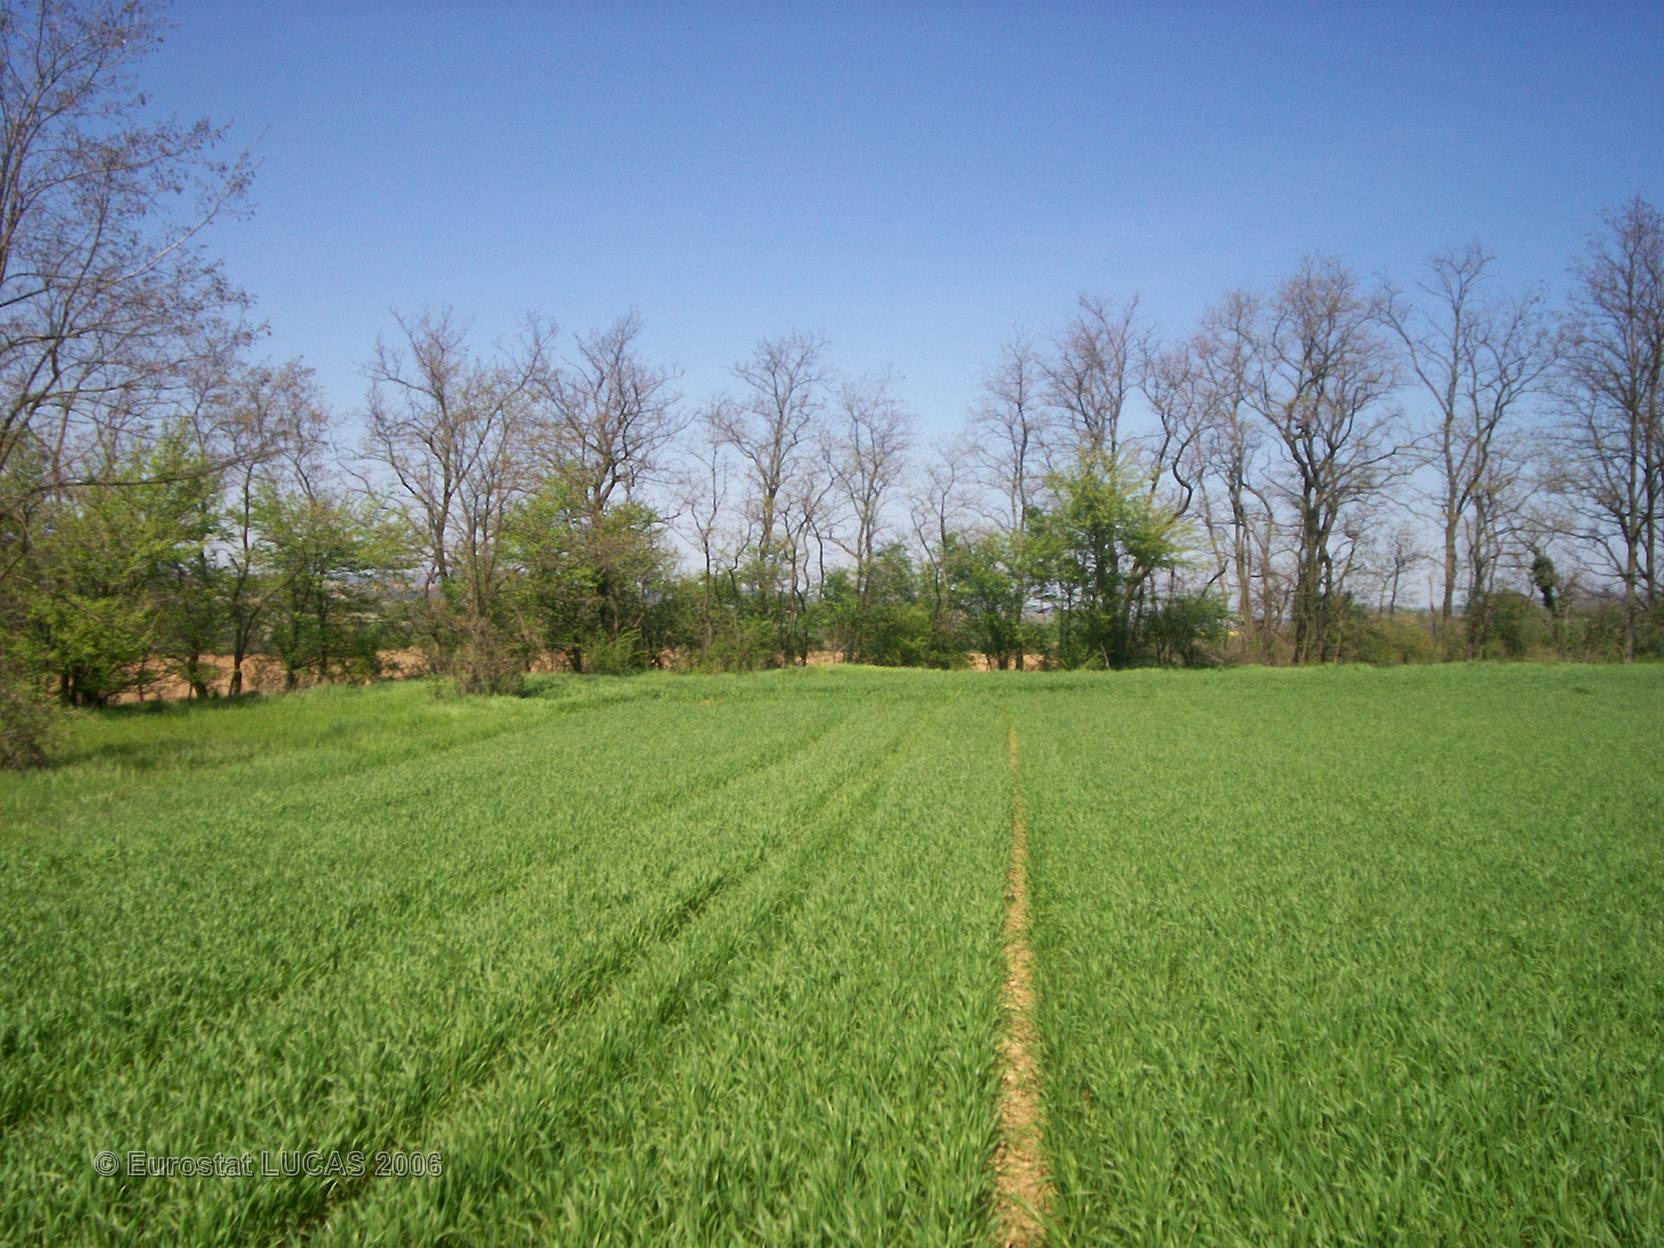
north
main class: Cropland
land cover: Common wheat
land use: Agriculture (excluding fallow land and kitchen gardens)
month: April
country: FR
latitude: 45.4318
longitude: 4.8276
